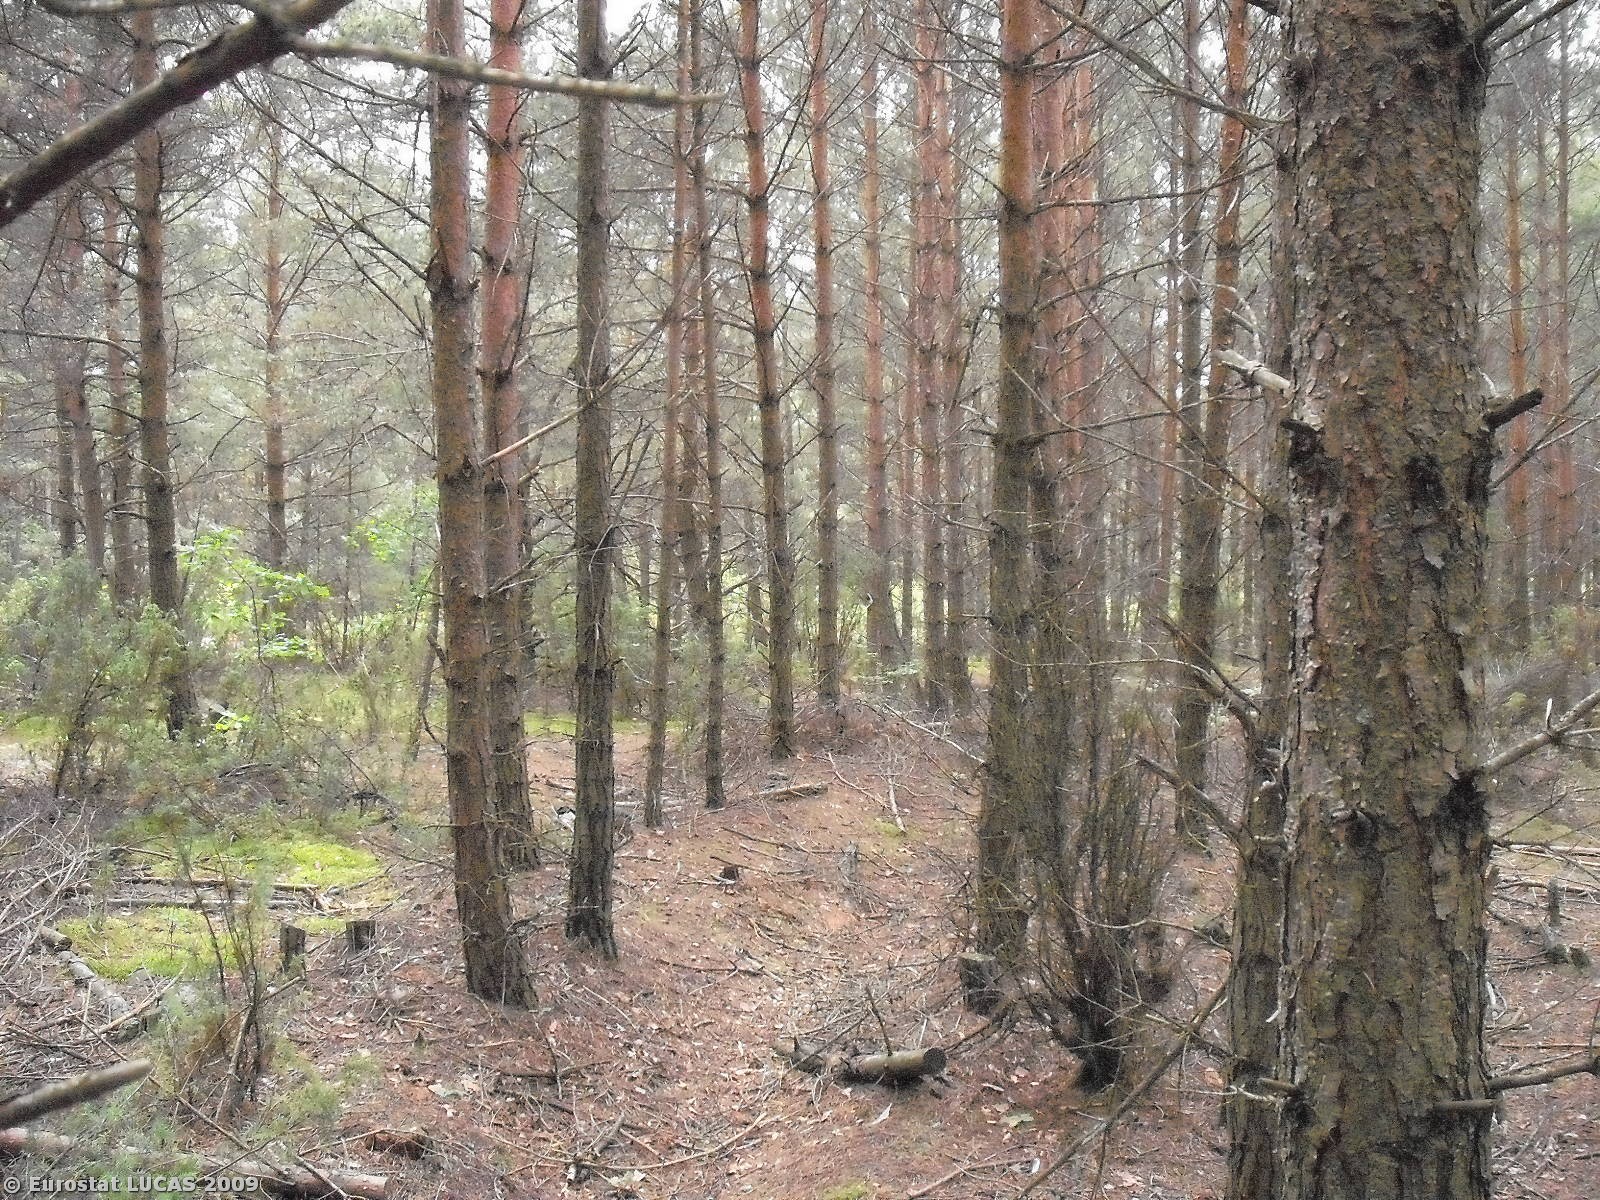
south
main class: Woodland
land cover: Coniferous woodland
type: hemiboreal forest and nemoral coniferous forest and mixed broadleaved-coniferous forest
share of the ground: > 75 %
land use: Forestry
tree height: > 5 m
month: June
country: PL
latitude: 51.2387
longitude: 20.5090
